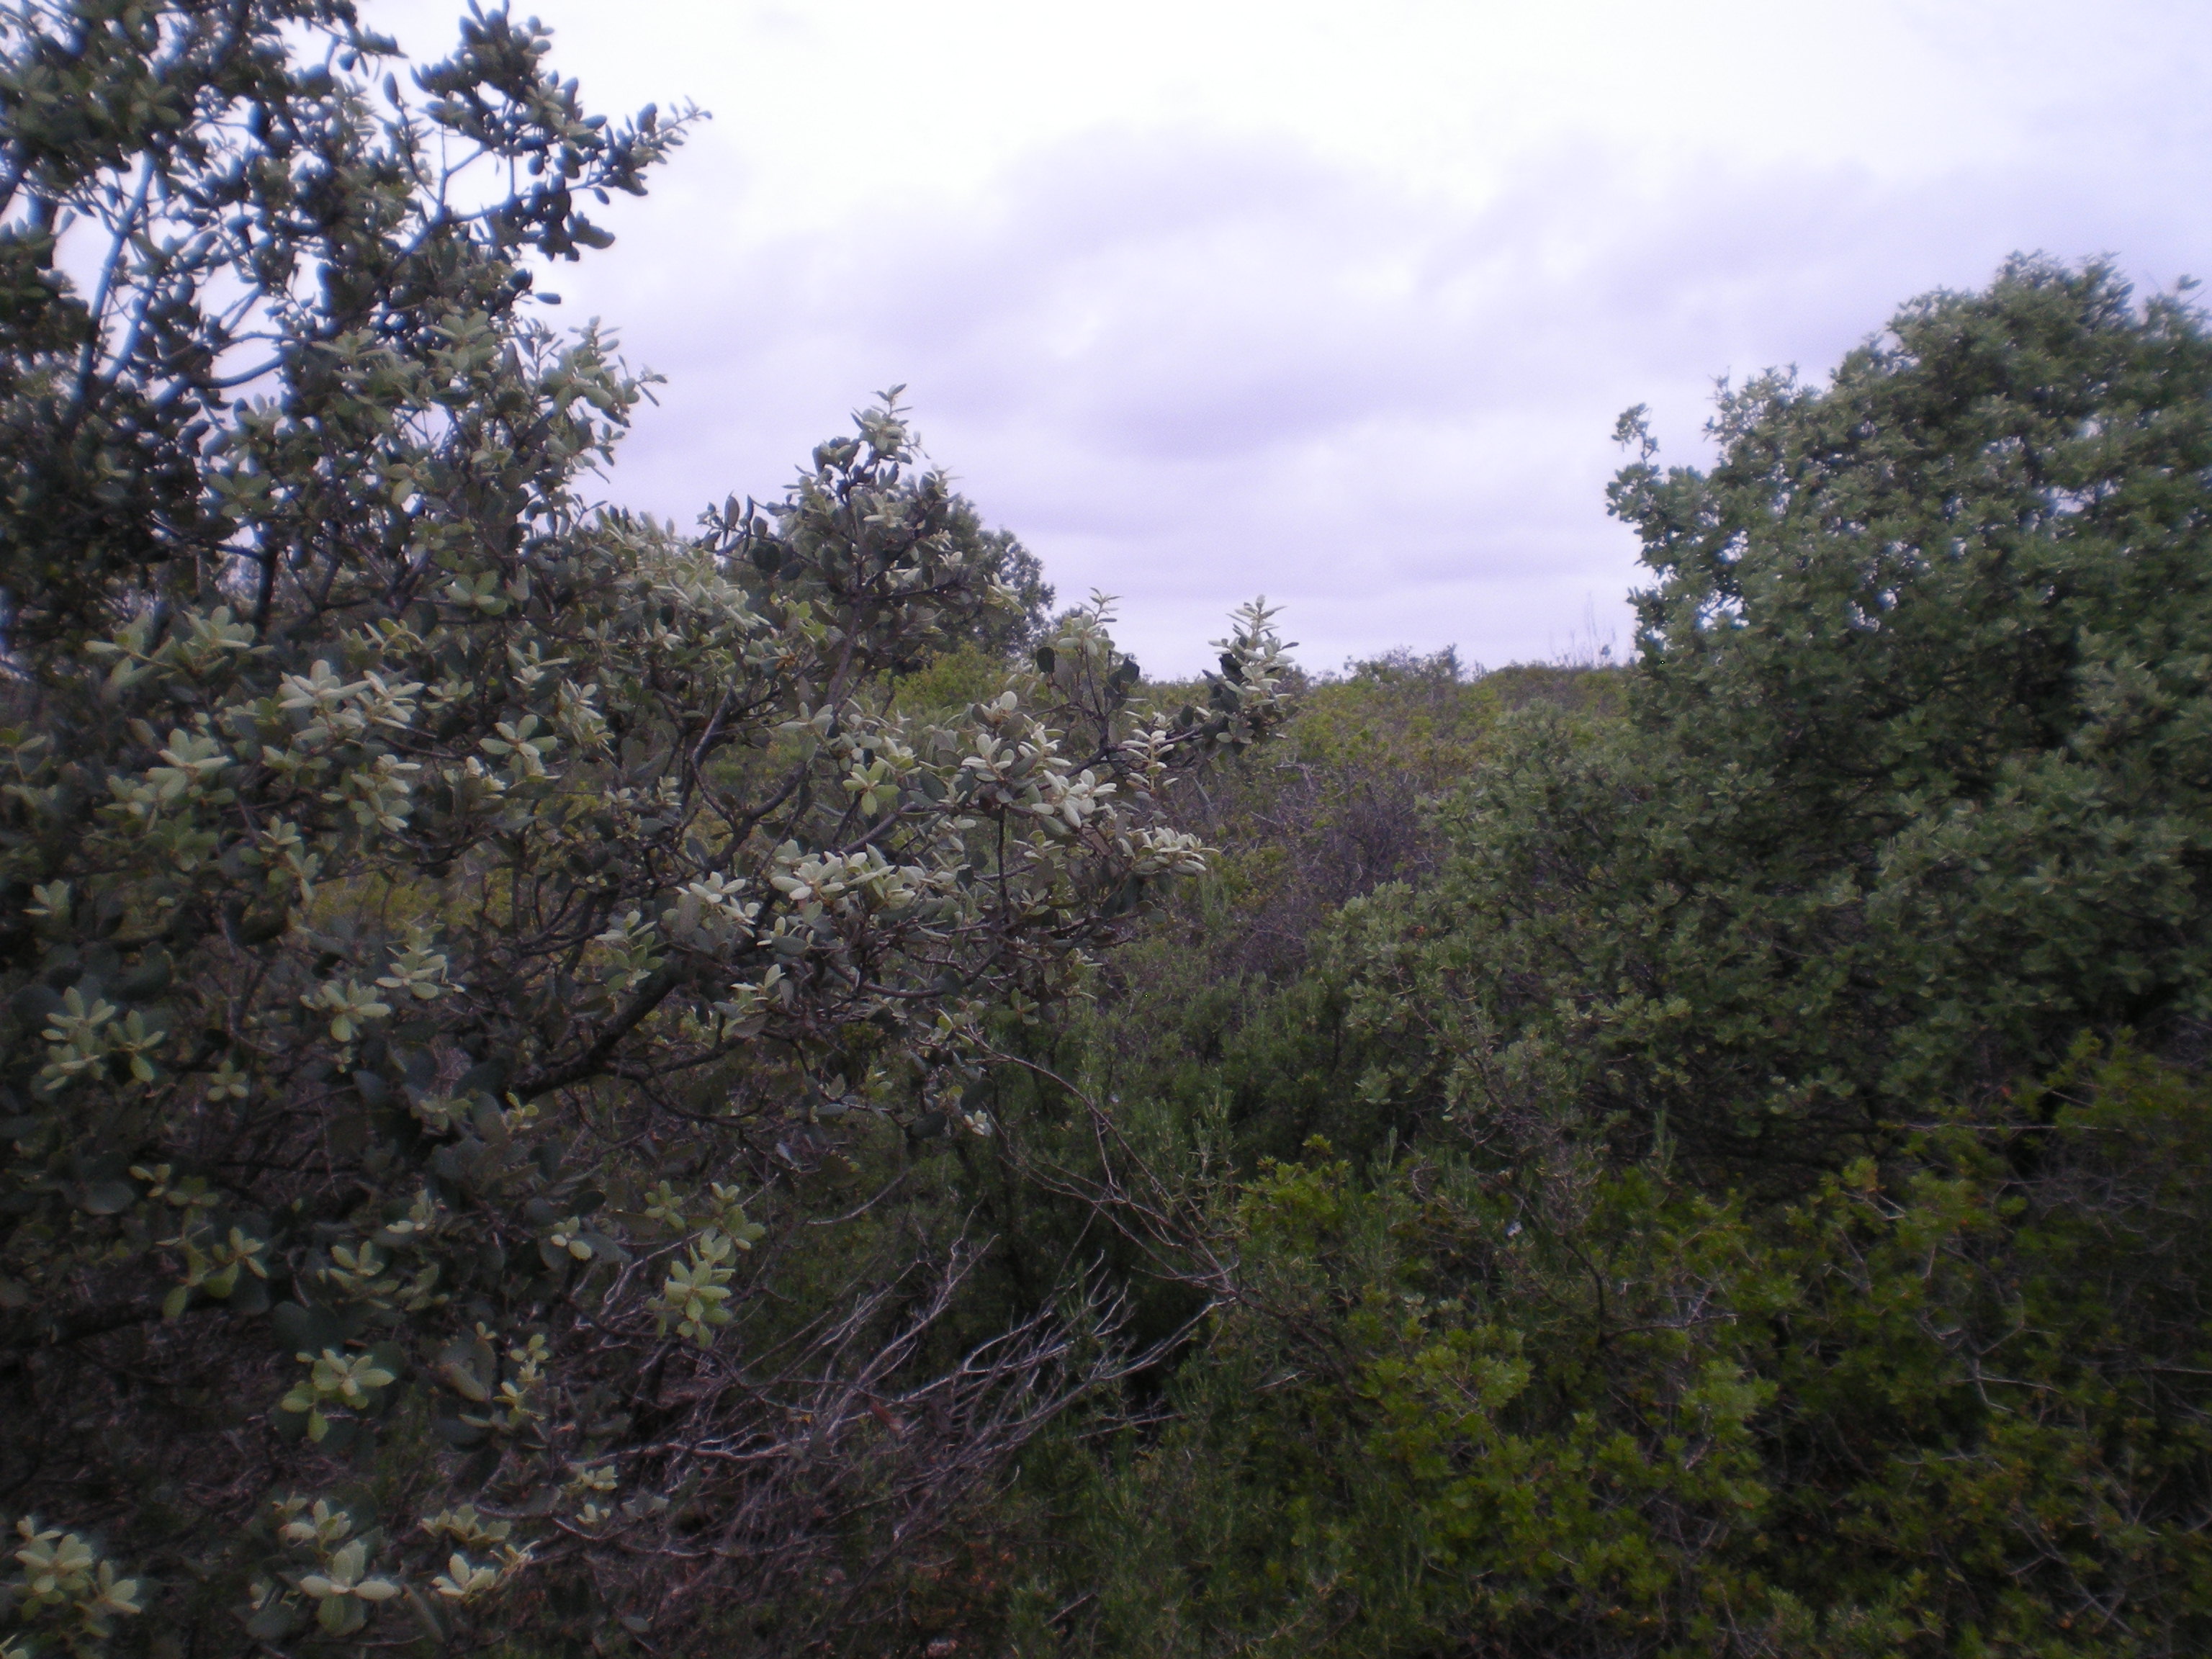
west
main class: Woodland
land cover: Broadleaved woodland
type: broadleaved evergreen forest
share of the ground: 50 - 75 %
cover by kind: broadleaved forest trees 40 %, shrubs 30 %, unconsolidated bare surface 20 %, herbaceous plants 10 %
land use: Other primary production
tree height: < 5 m
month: May
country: ES
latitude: 38.8352
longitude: -2.9678
